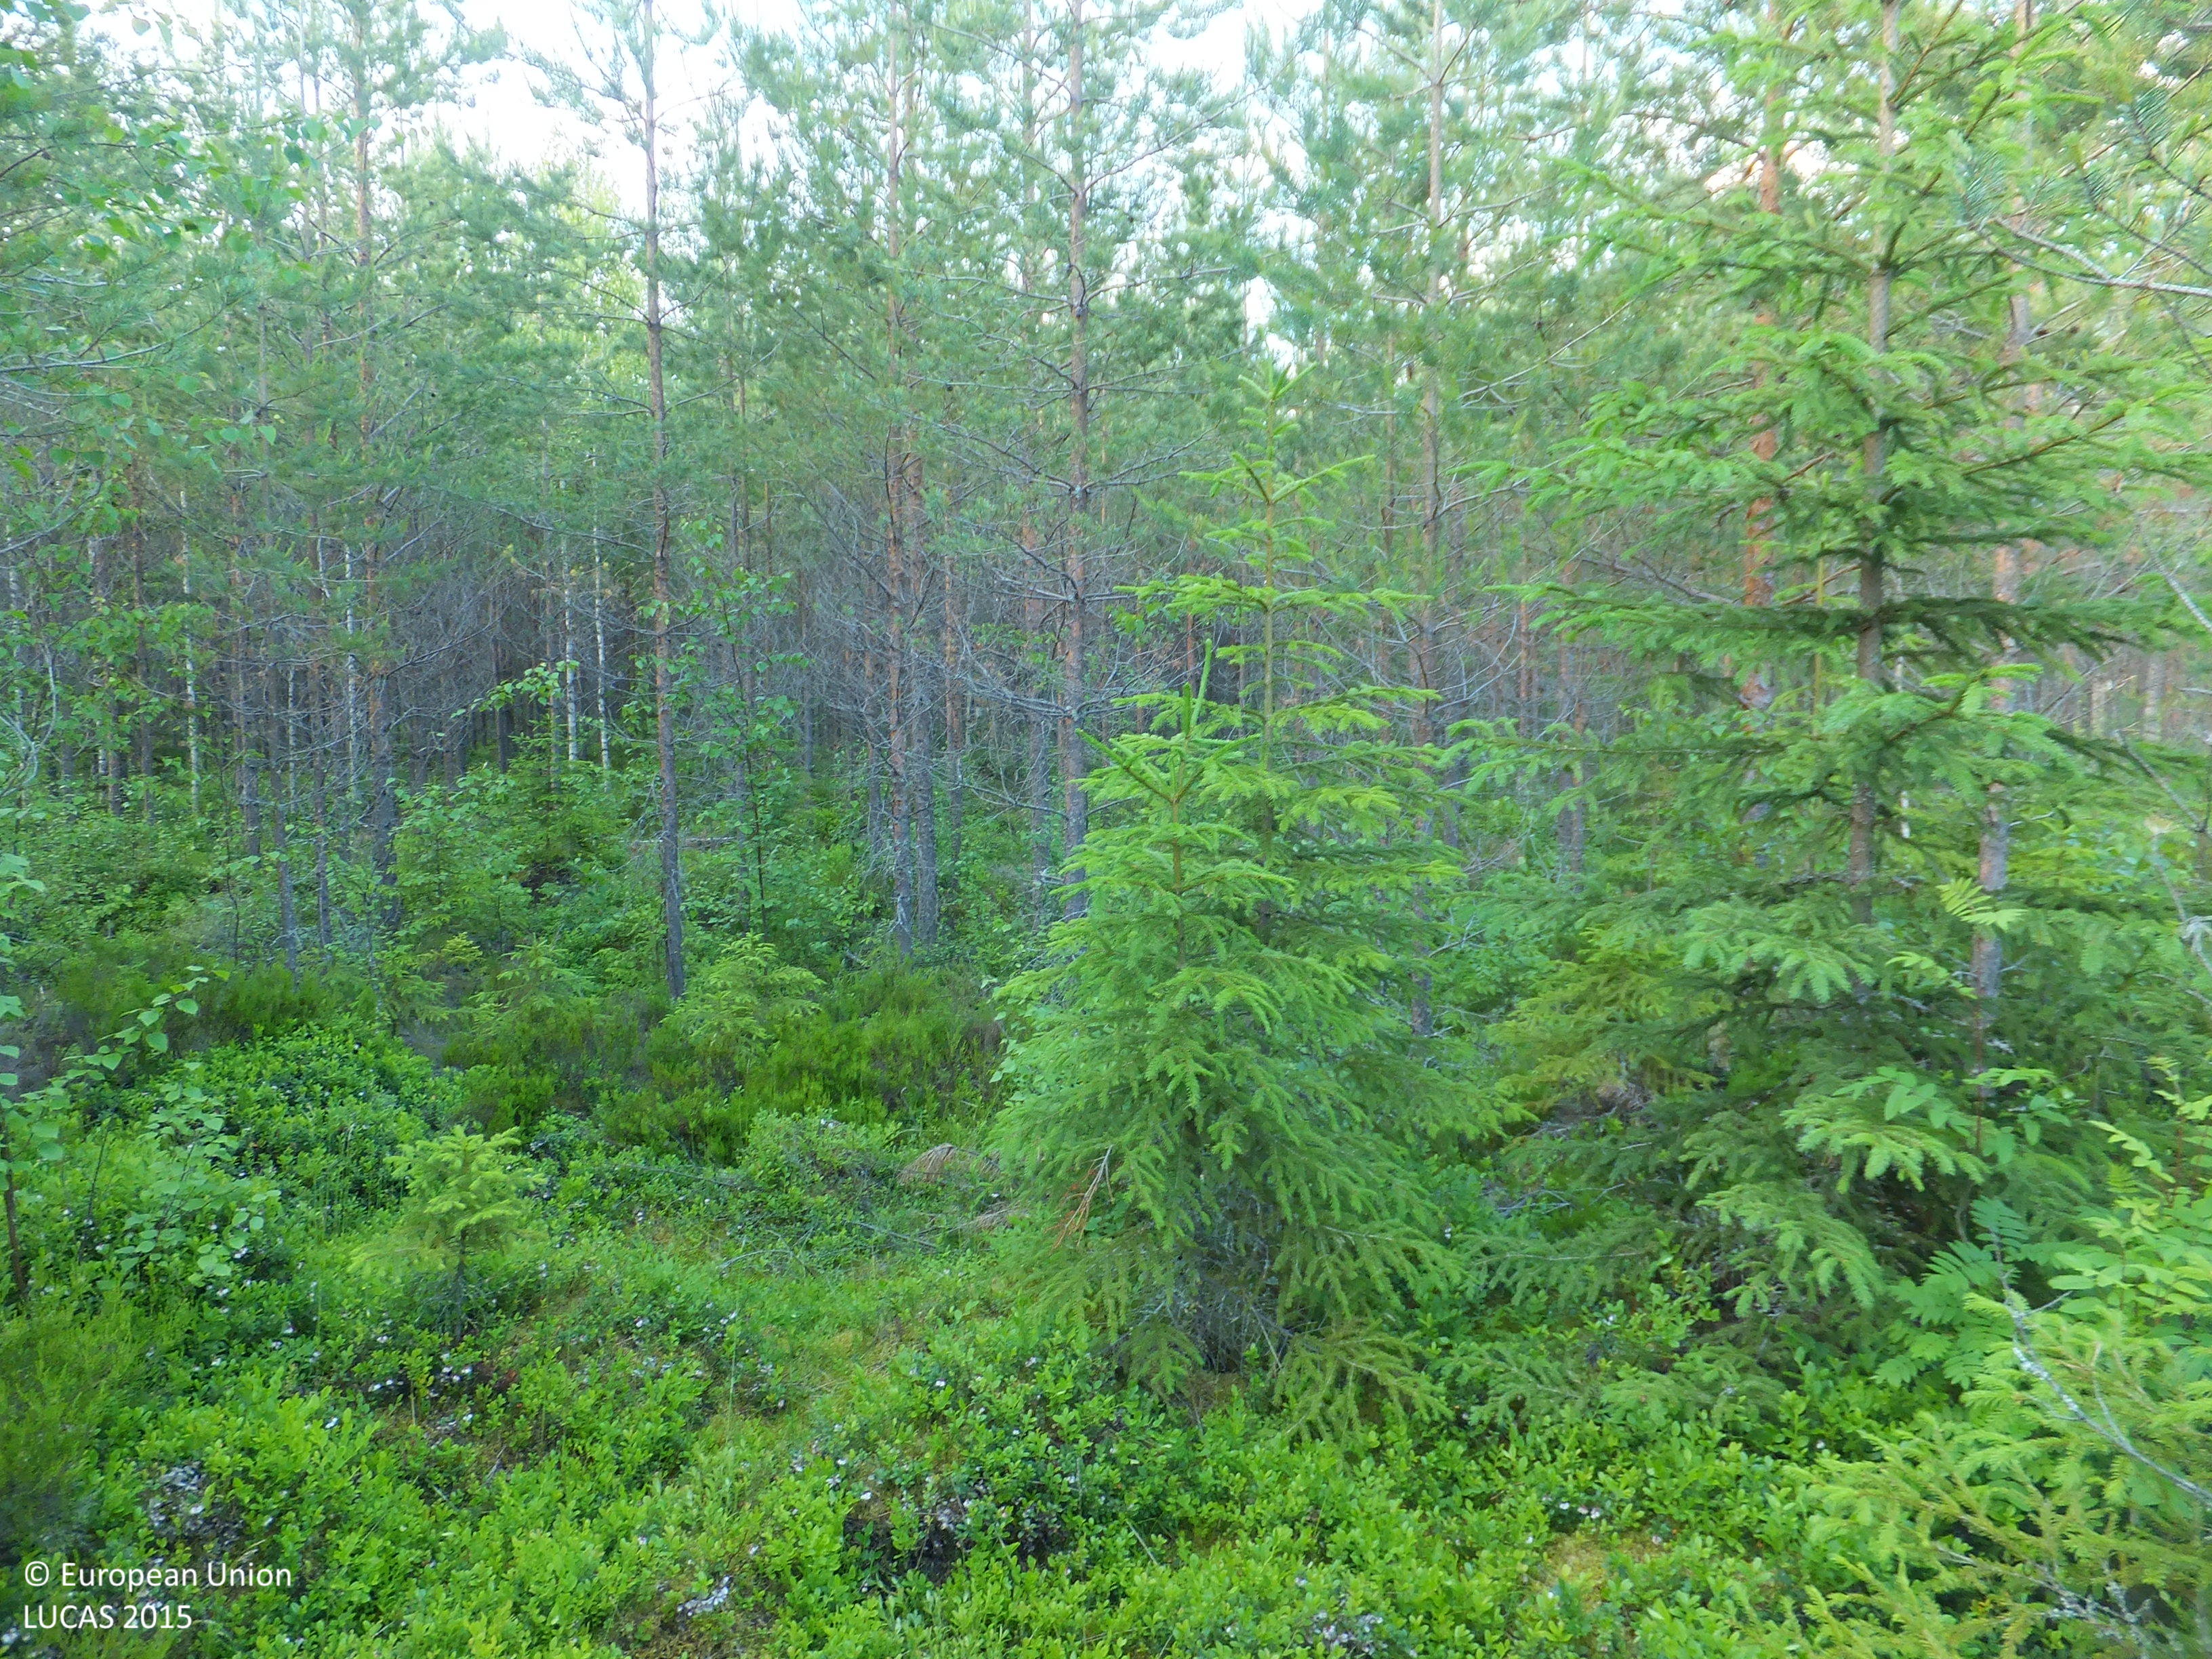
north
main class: Woodland
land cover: Other coniferous woodland
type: boreal forest
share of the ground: 50 - 75 %
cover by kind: coniferous forest trees 50 %, shrubs 25 %, consolidated bare surface 15 %, broadleaved forest trees 5 %, herbaceous plants 5 %
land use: Forestry
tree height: > 5 m
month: July
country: FI
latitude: 63.0827
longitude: 23.7114
